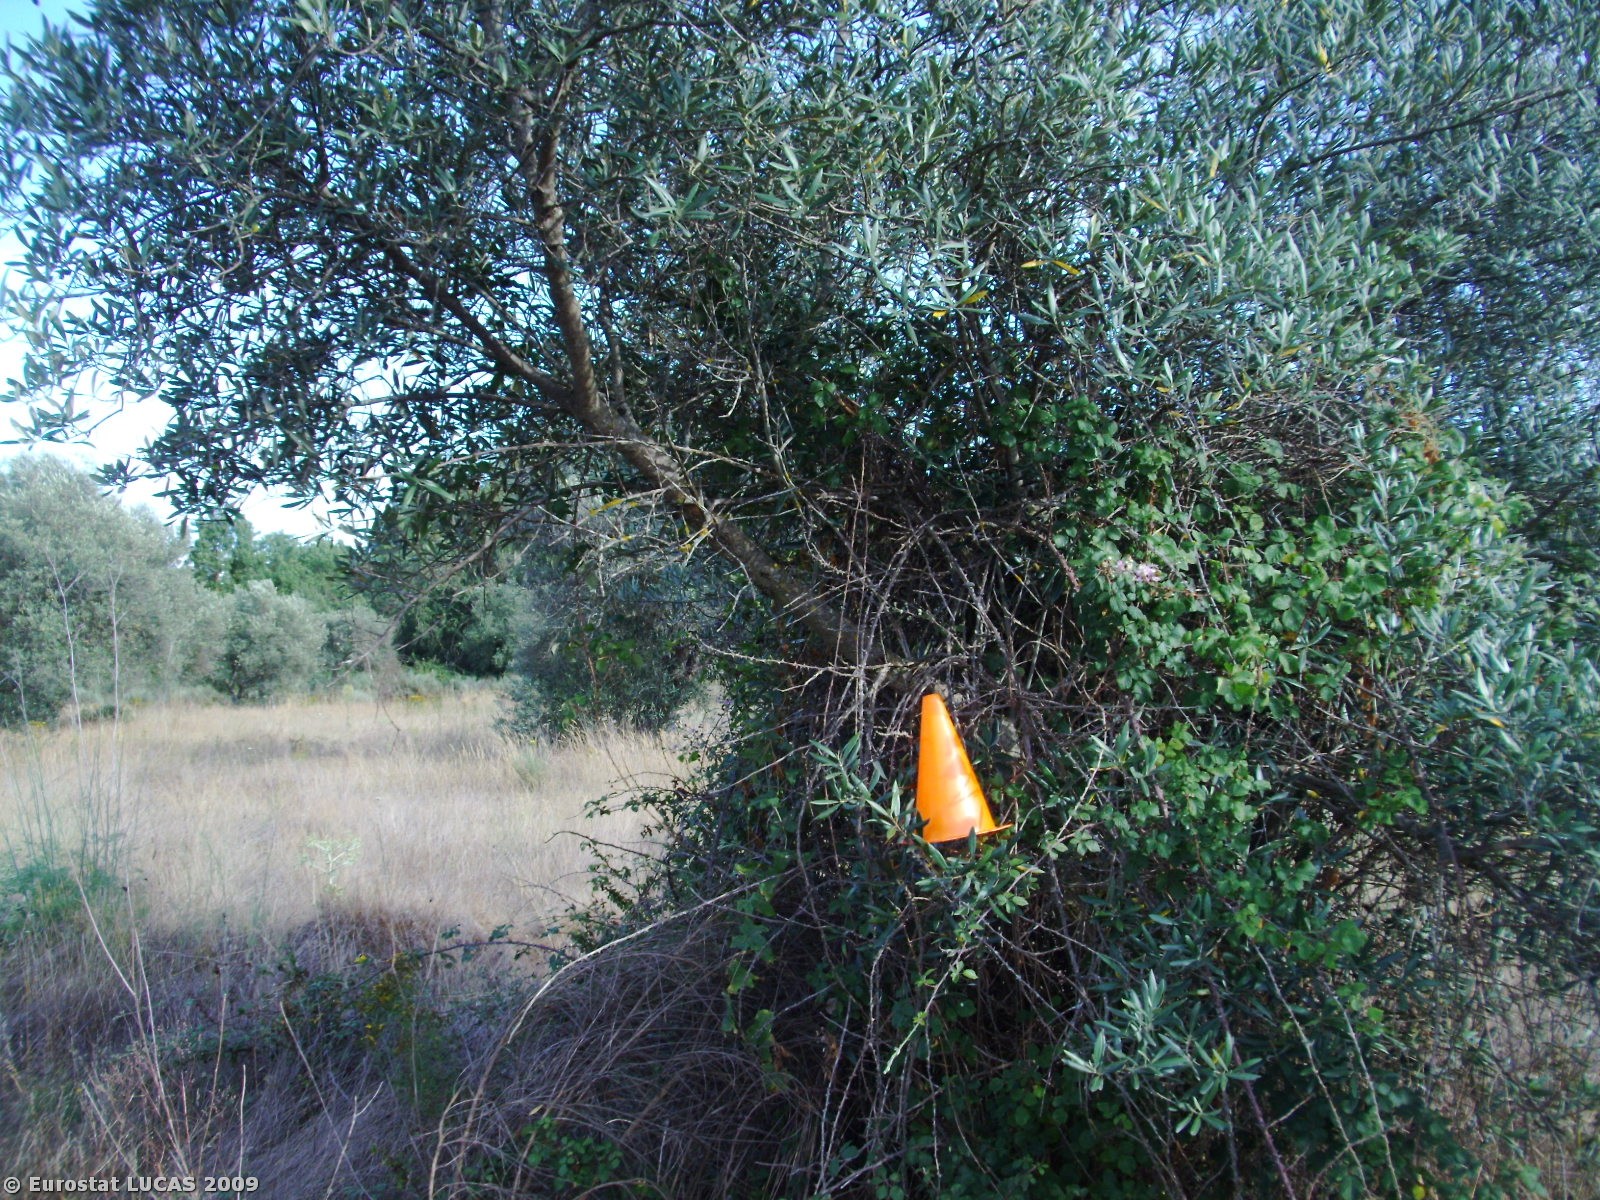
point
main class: Cropland
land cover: Olive groves
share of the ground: 10 - 25 %
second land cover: Spontaneously vegetated surfaces
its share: > 75 %
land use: Agriculture (excluding fallow land and kitchen gardens)
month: July
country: PT
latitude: 40.2296
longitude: -7.1993
